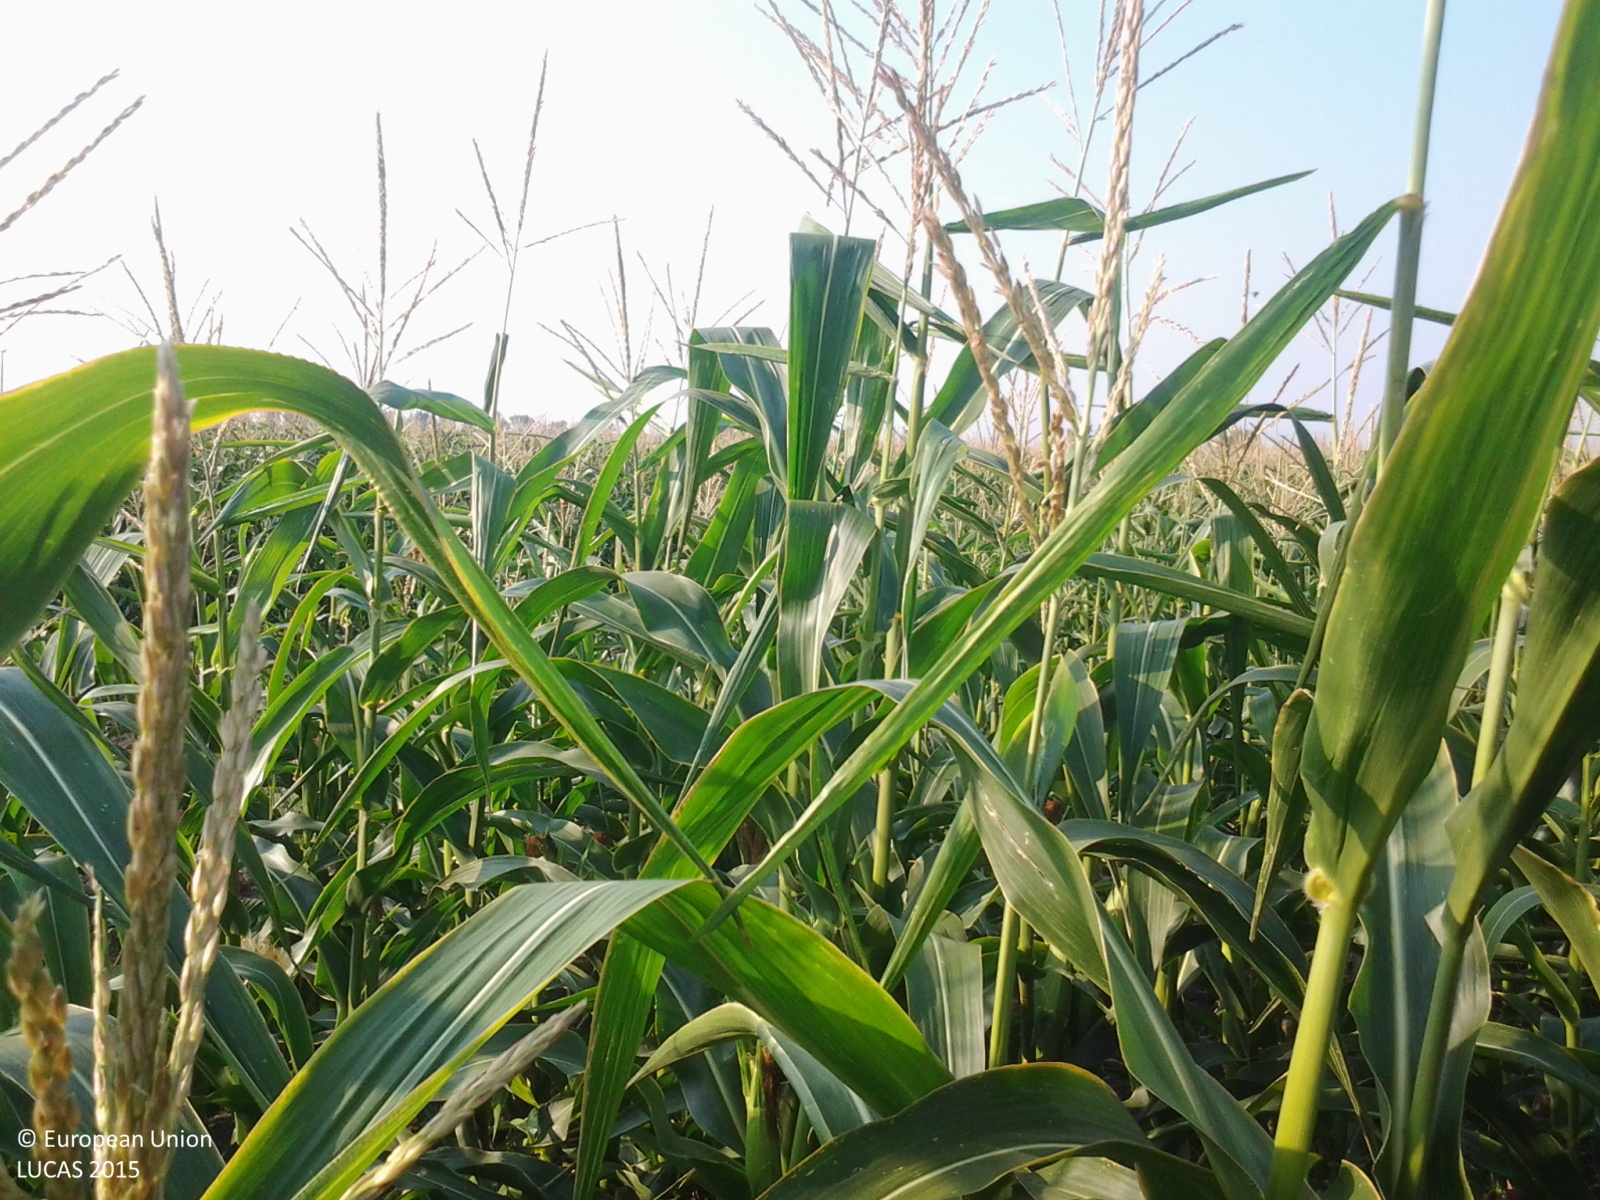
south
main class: Cropland
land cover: Maize
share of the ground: > 75 %
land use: Agriculture (excluding fallow land and kitchen gardens)
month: July
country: HU
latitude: 46.9681
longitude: 20.7697
